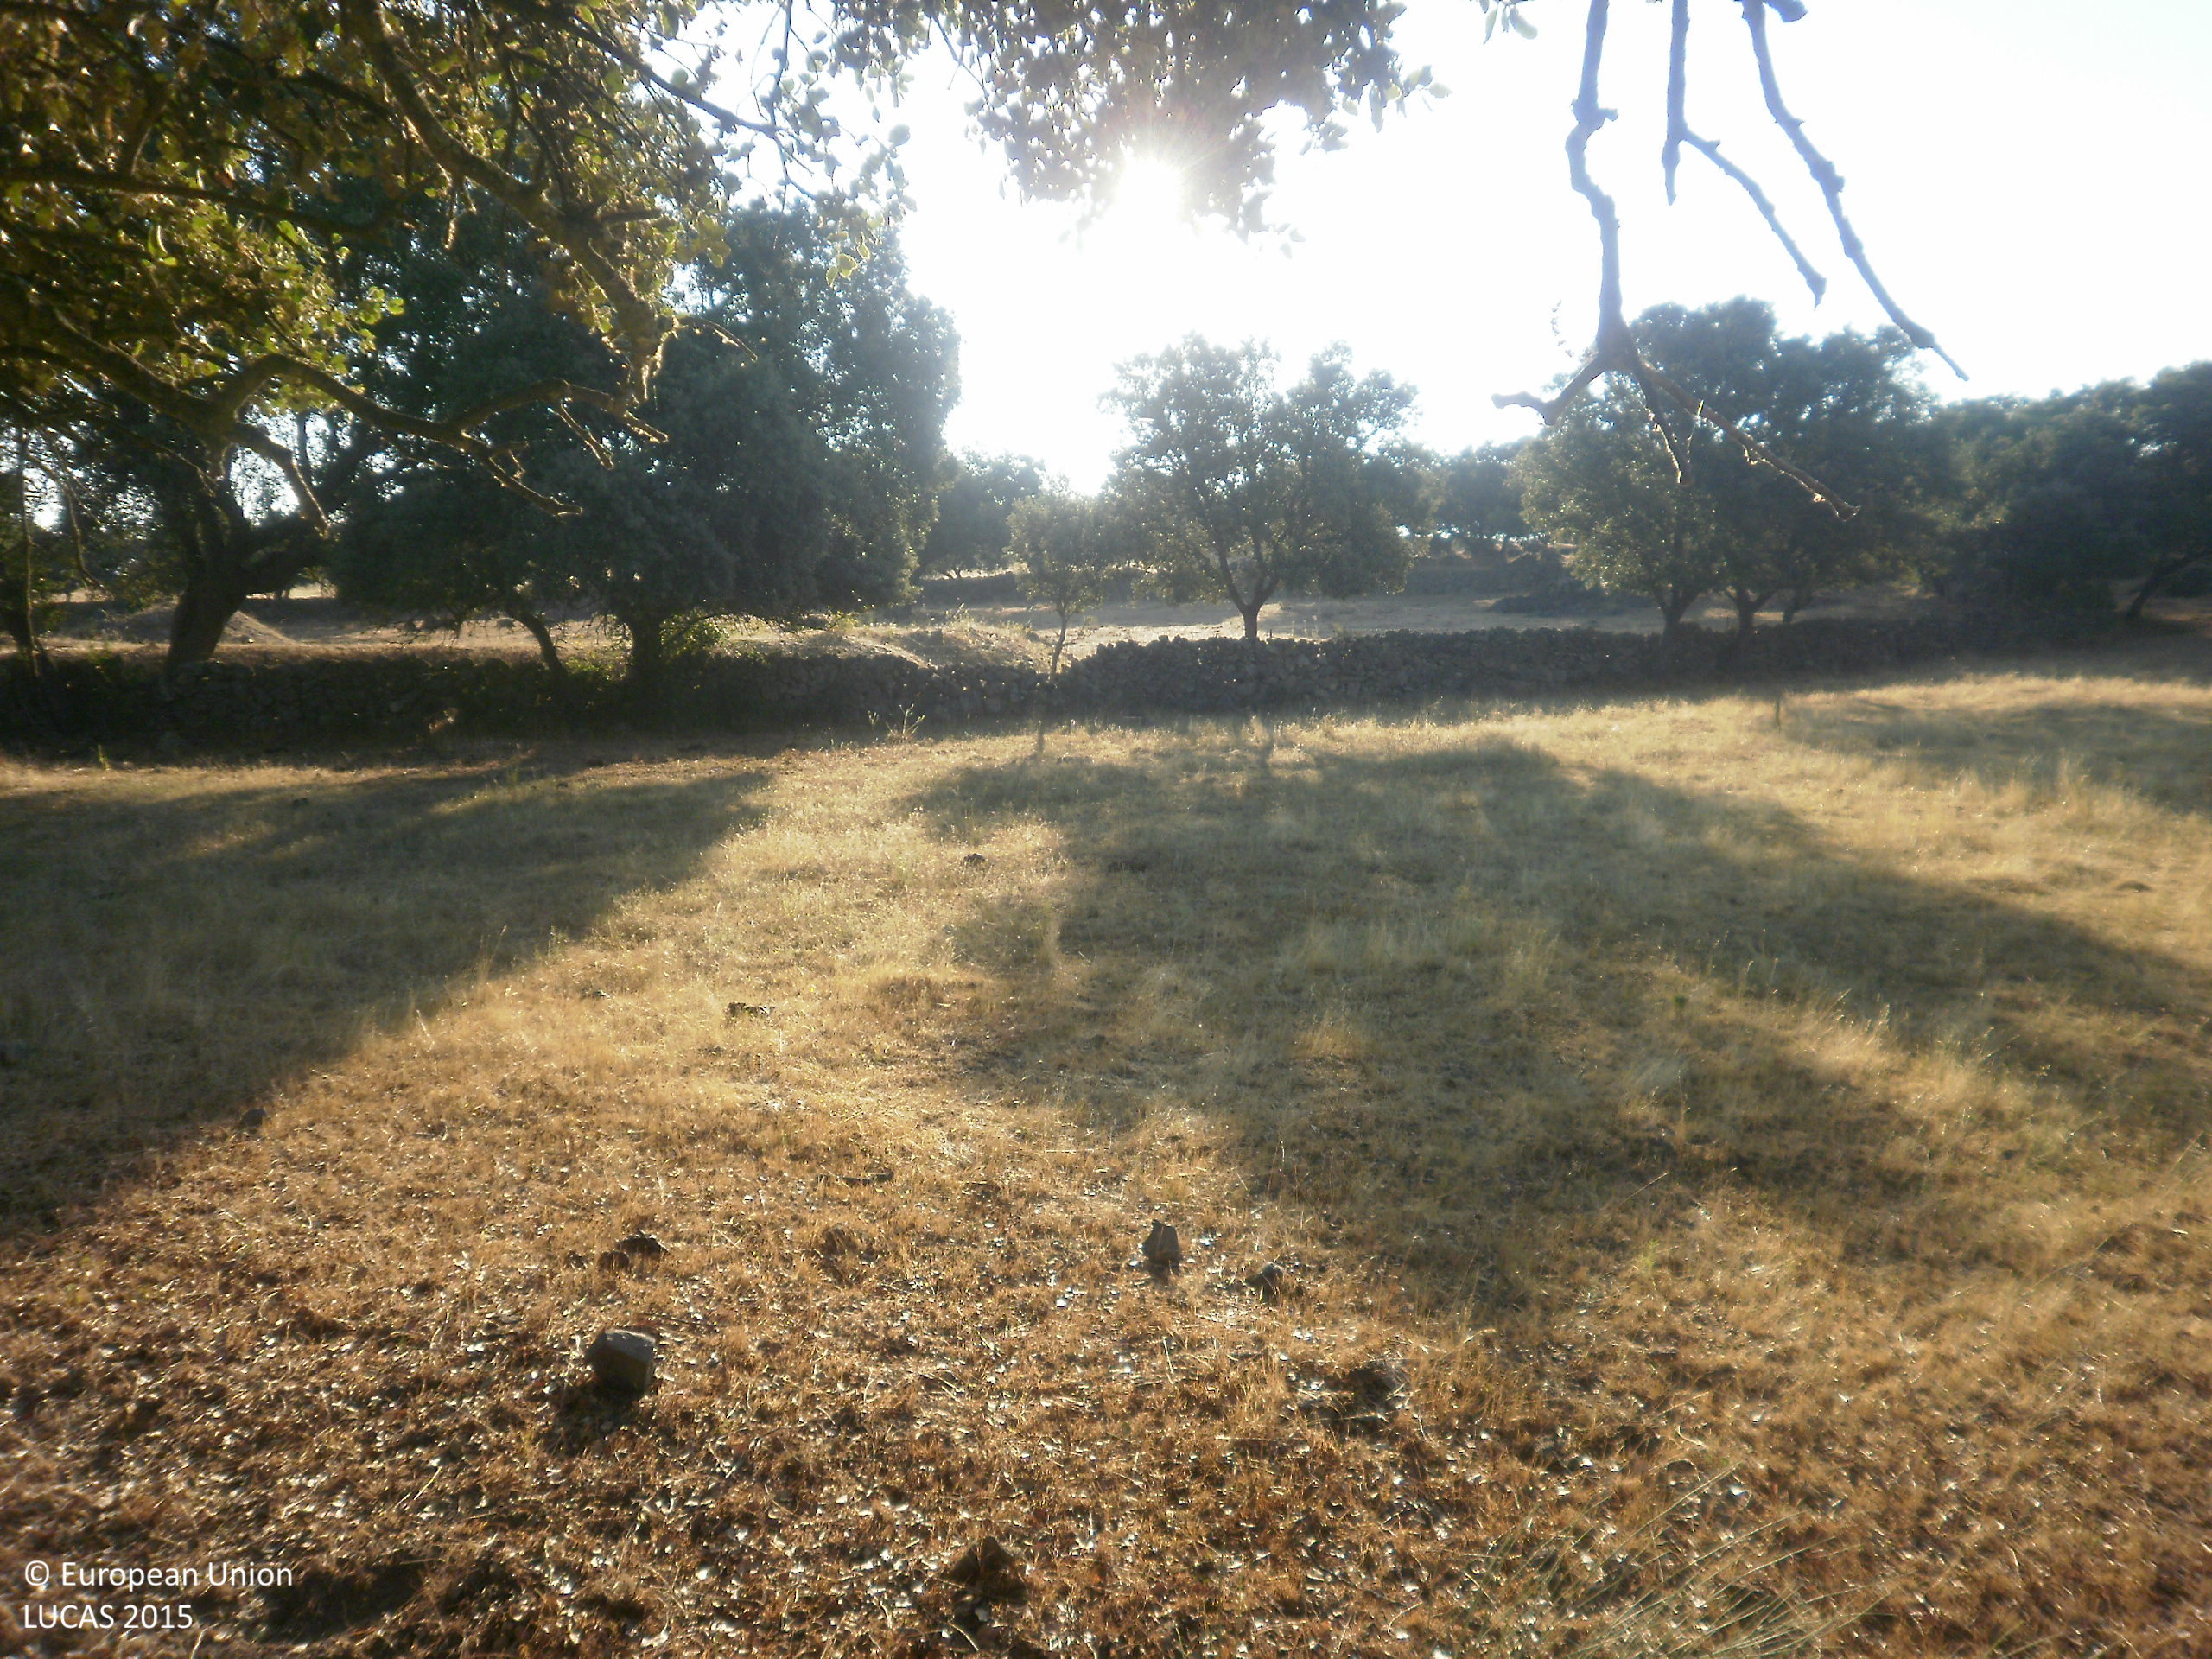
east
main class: Woodland
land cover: Broadleaved woodland
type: broadleaved evergreen forest
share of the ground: 10 - 25 %
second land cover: Grassland without tree/shrub cover
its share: 50 - 75 %
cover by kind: herbaceous plants 90 %, broadleaved forest trees 10 %
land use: Forestry
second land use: Agriculture (excluding fallow land and kitchen gardens)
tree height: > 5 m
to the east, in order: Broadleaved woodland; Grassland without tree/shrub cover; Dry stone walls; Broadleaved woodland; Dry stone walls; Broadleaved woodland; Dry stone walls; Broadleaved woodland
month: June
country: ES
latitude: 39.2867
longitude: -6.0459
